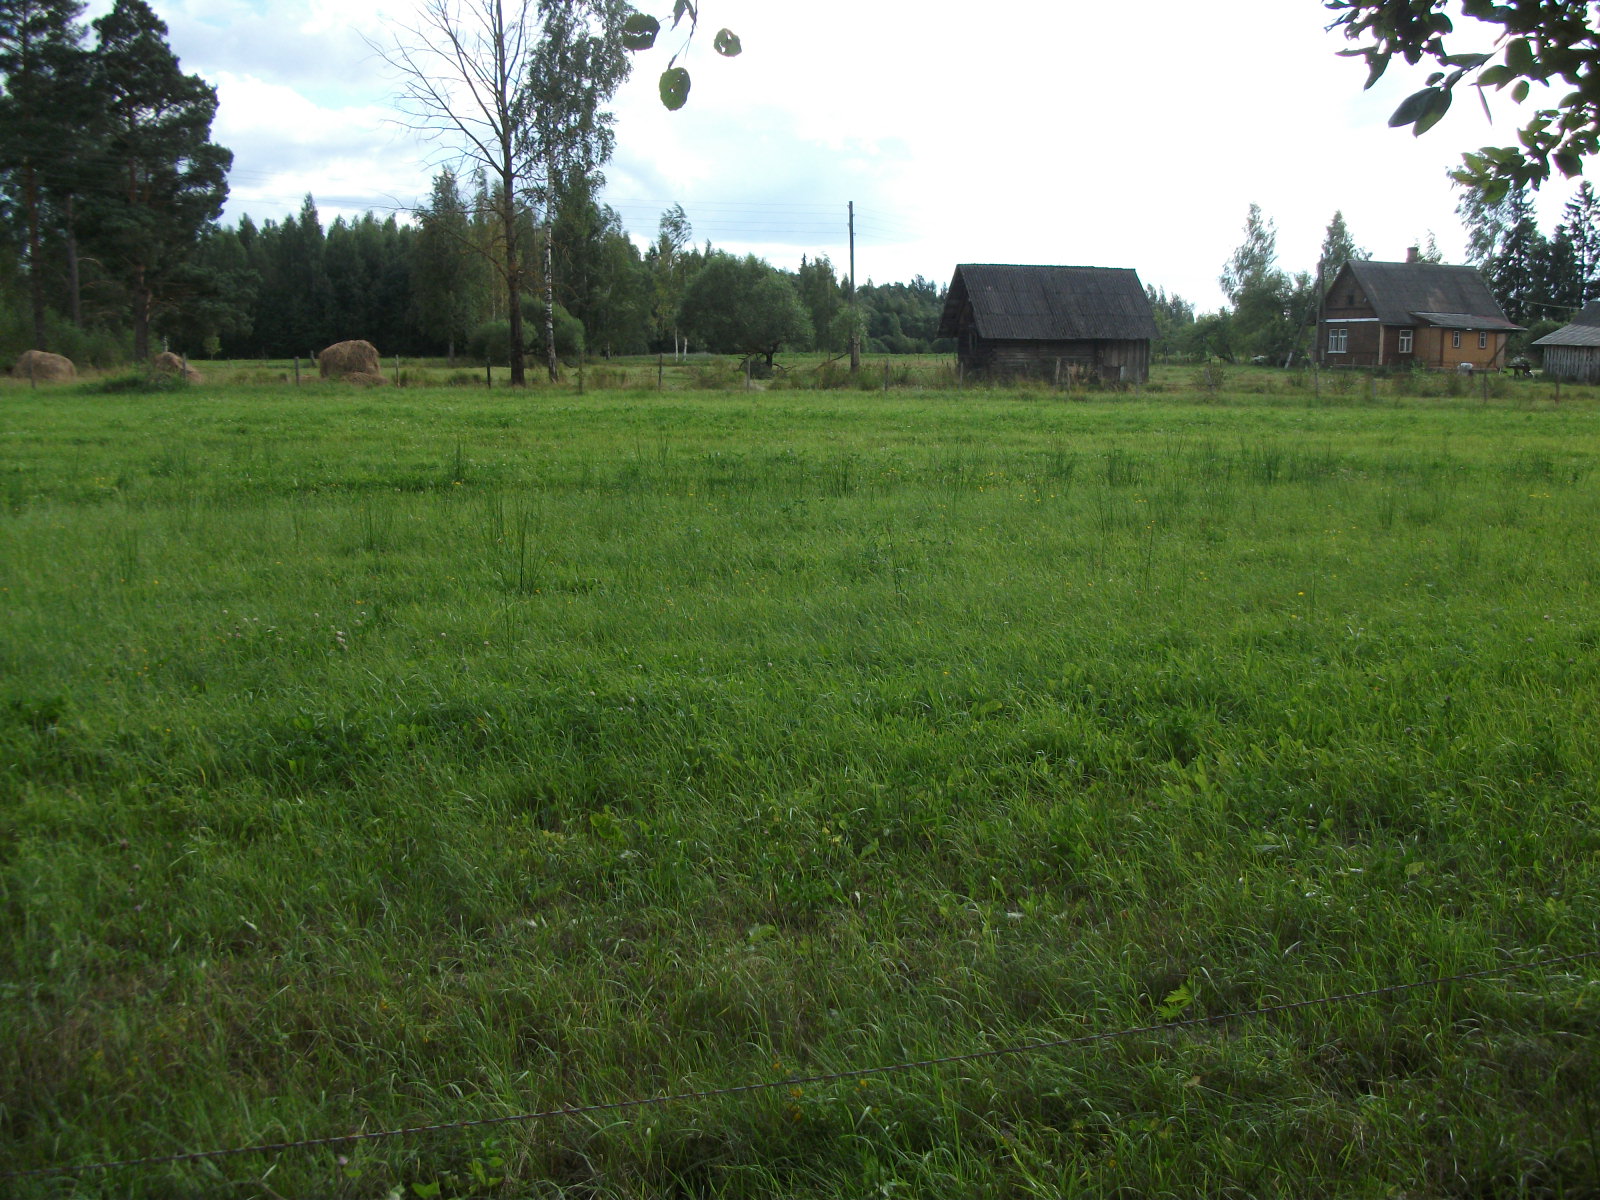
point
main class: Grassland
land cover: Grassland without tree/shrub cover
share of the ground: > 75 %
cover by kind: herbaceous plants 100 %
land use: Agriculture (excluding fallow land and kitchen gardens)
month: August
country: LV
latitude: 56.4873
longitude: 26.3677
